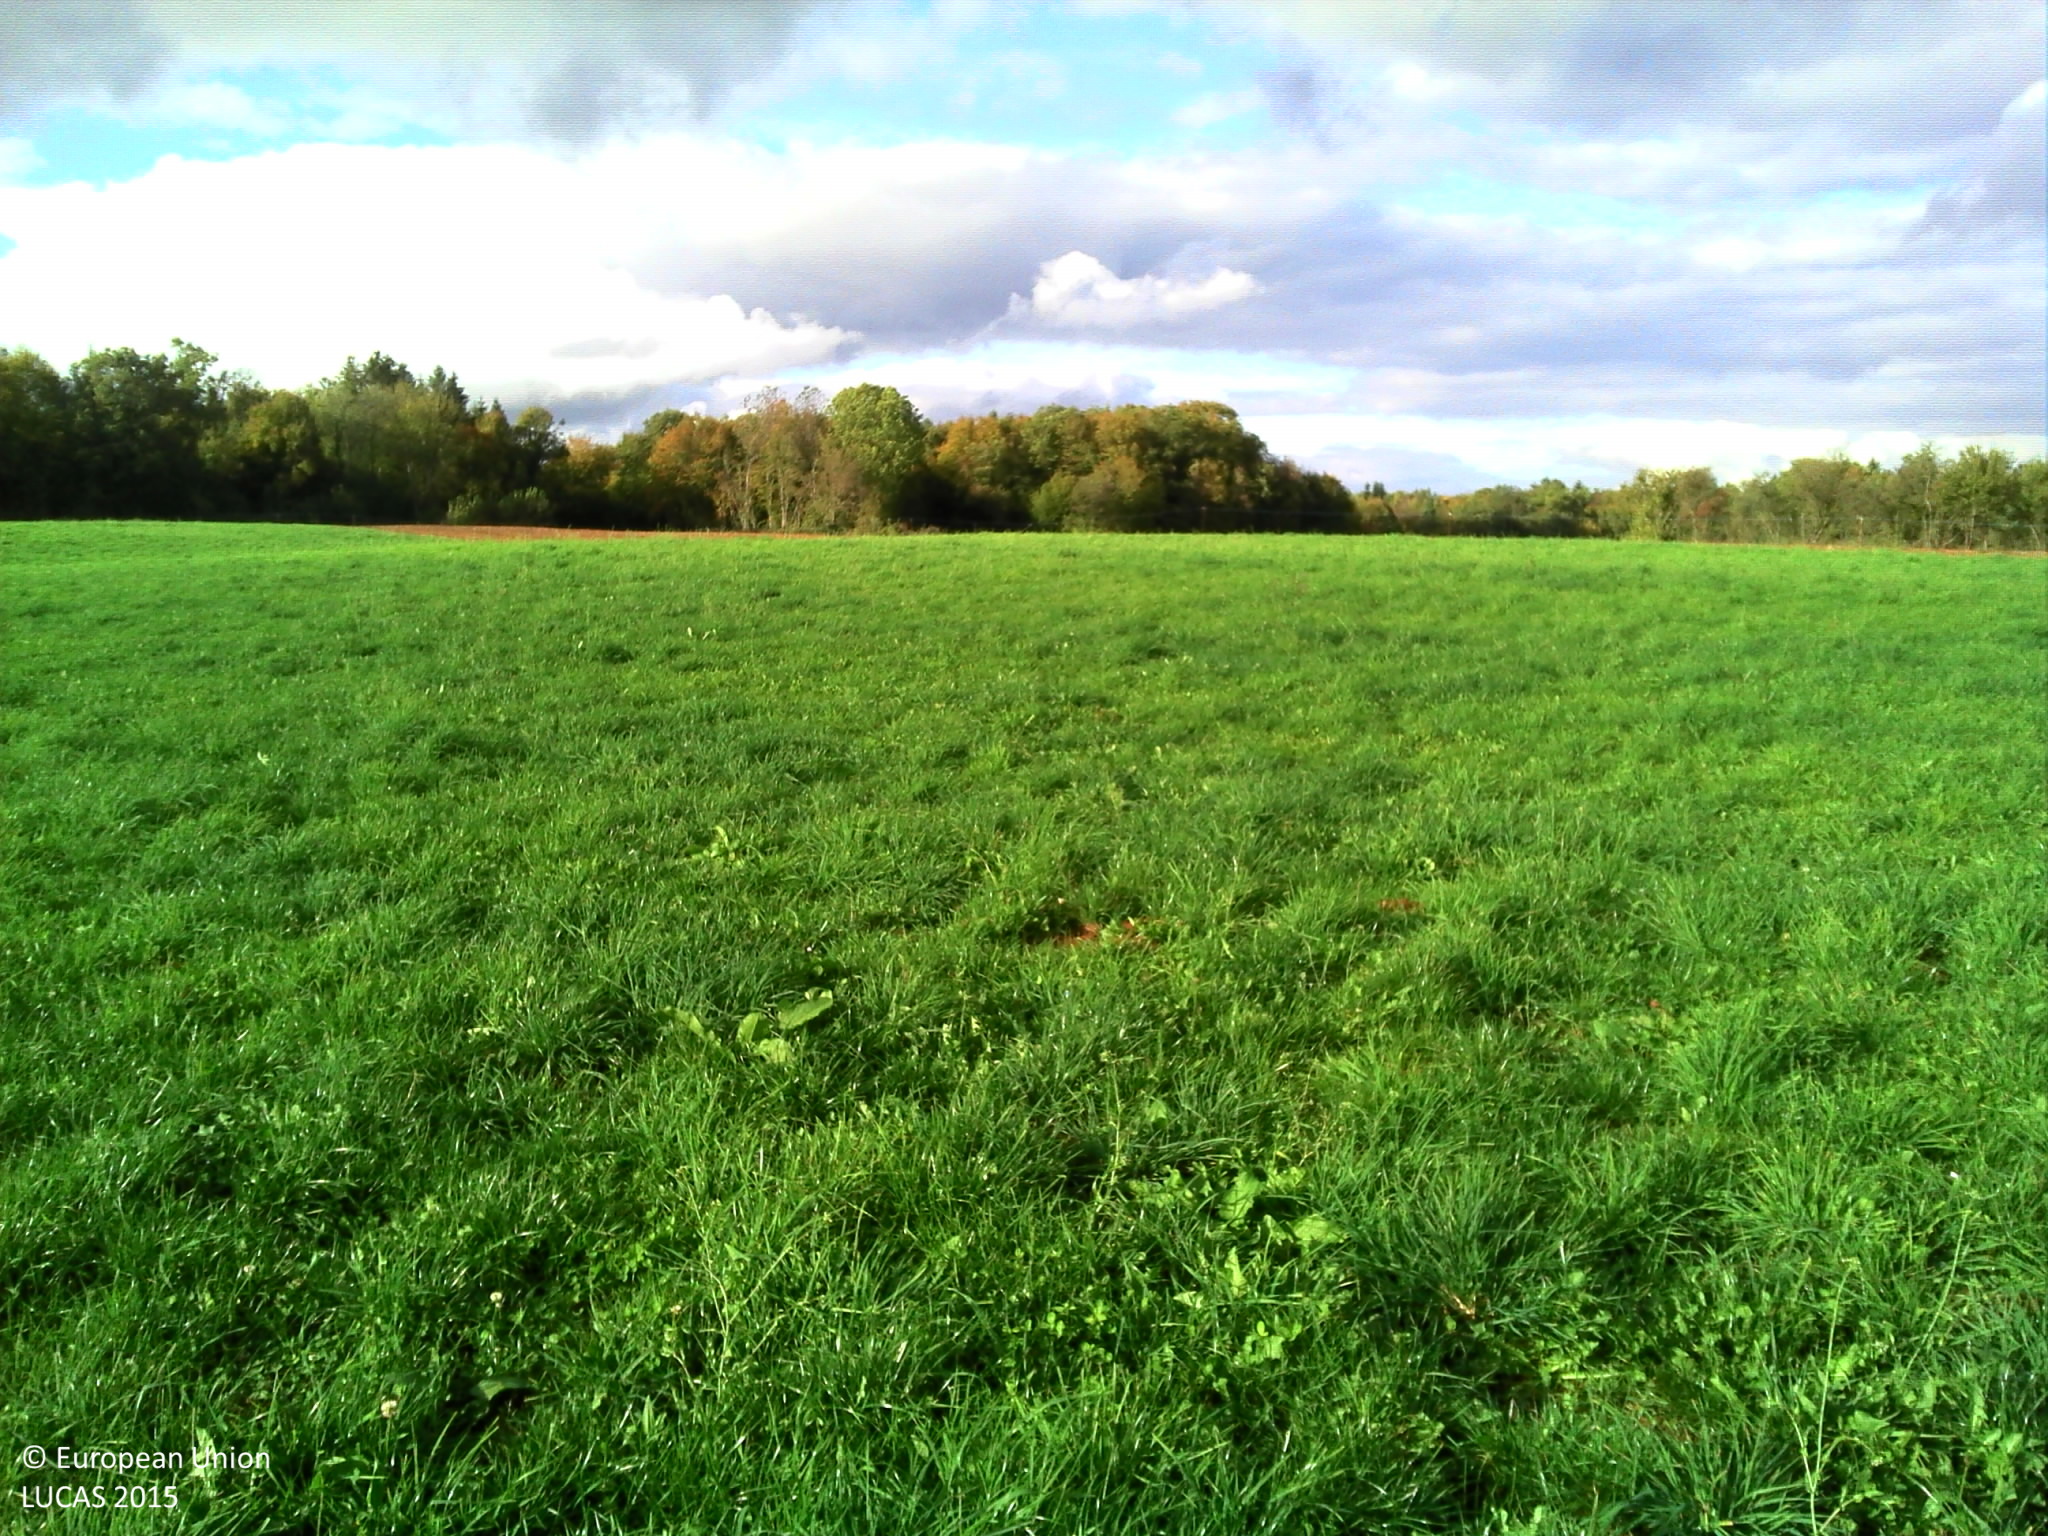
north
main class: Grassland
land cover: Grassland without tree/shrub cover
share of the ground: > 75 %
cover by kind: herbaceous plants 100 %
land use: Agriculture (excluding fallow land and kitchen gardens)
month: October
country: FR
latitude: 47.1251
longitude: 6.0342
